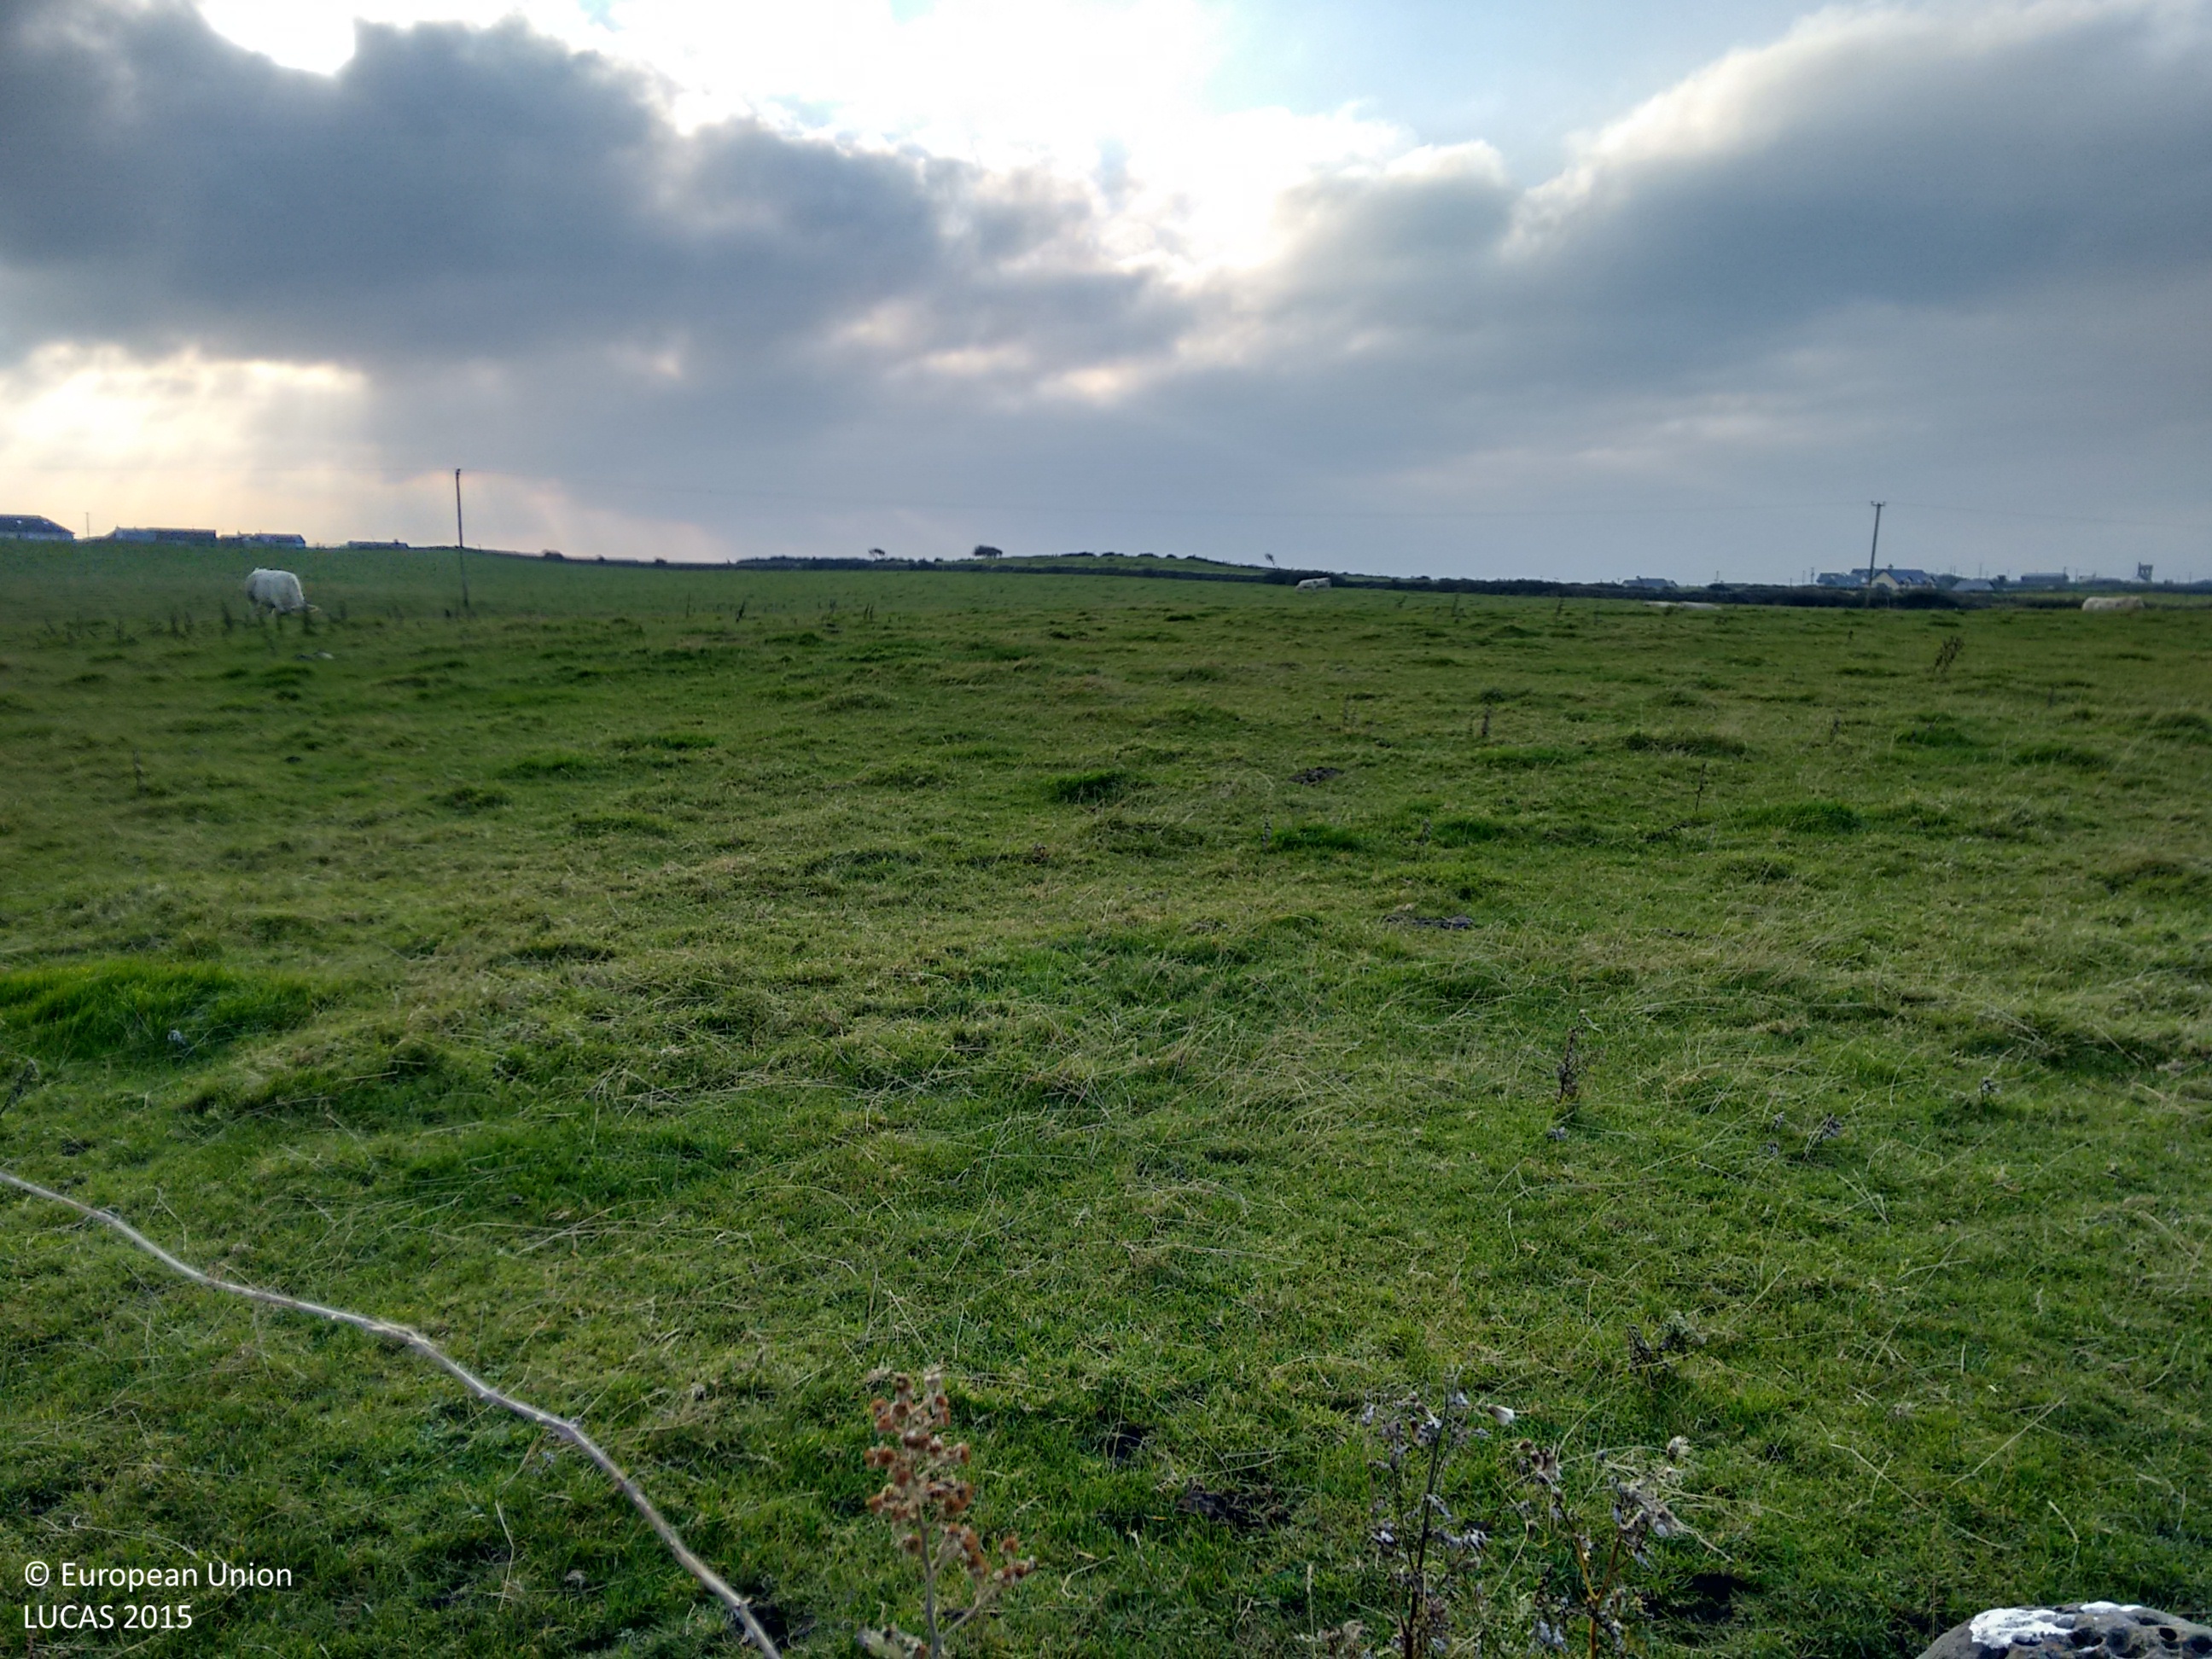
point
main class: Grassland
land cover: Grassland without tree/shrub cover
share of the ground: > 75 %
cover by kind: herbaceous plants 100 %
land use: Agriculture (excluding fallow land and kitchen gardens)
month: November
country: IE
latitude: 54.2794
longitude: -9.0264
